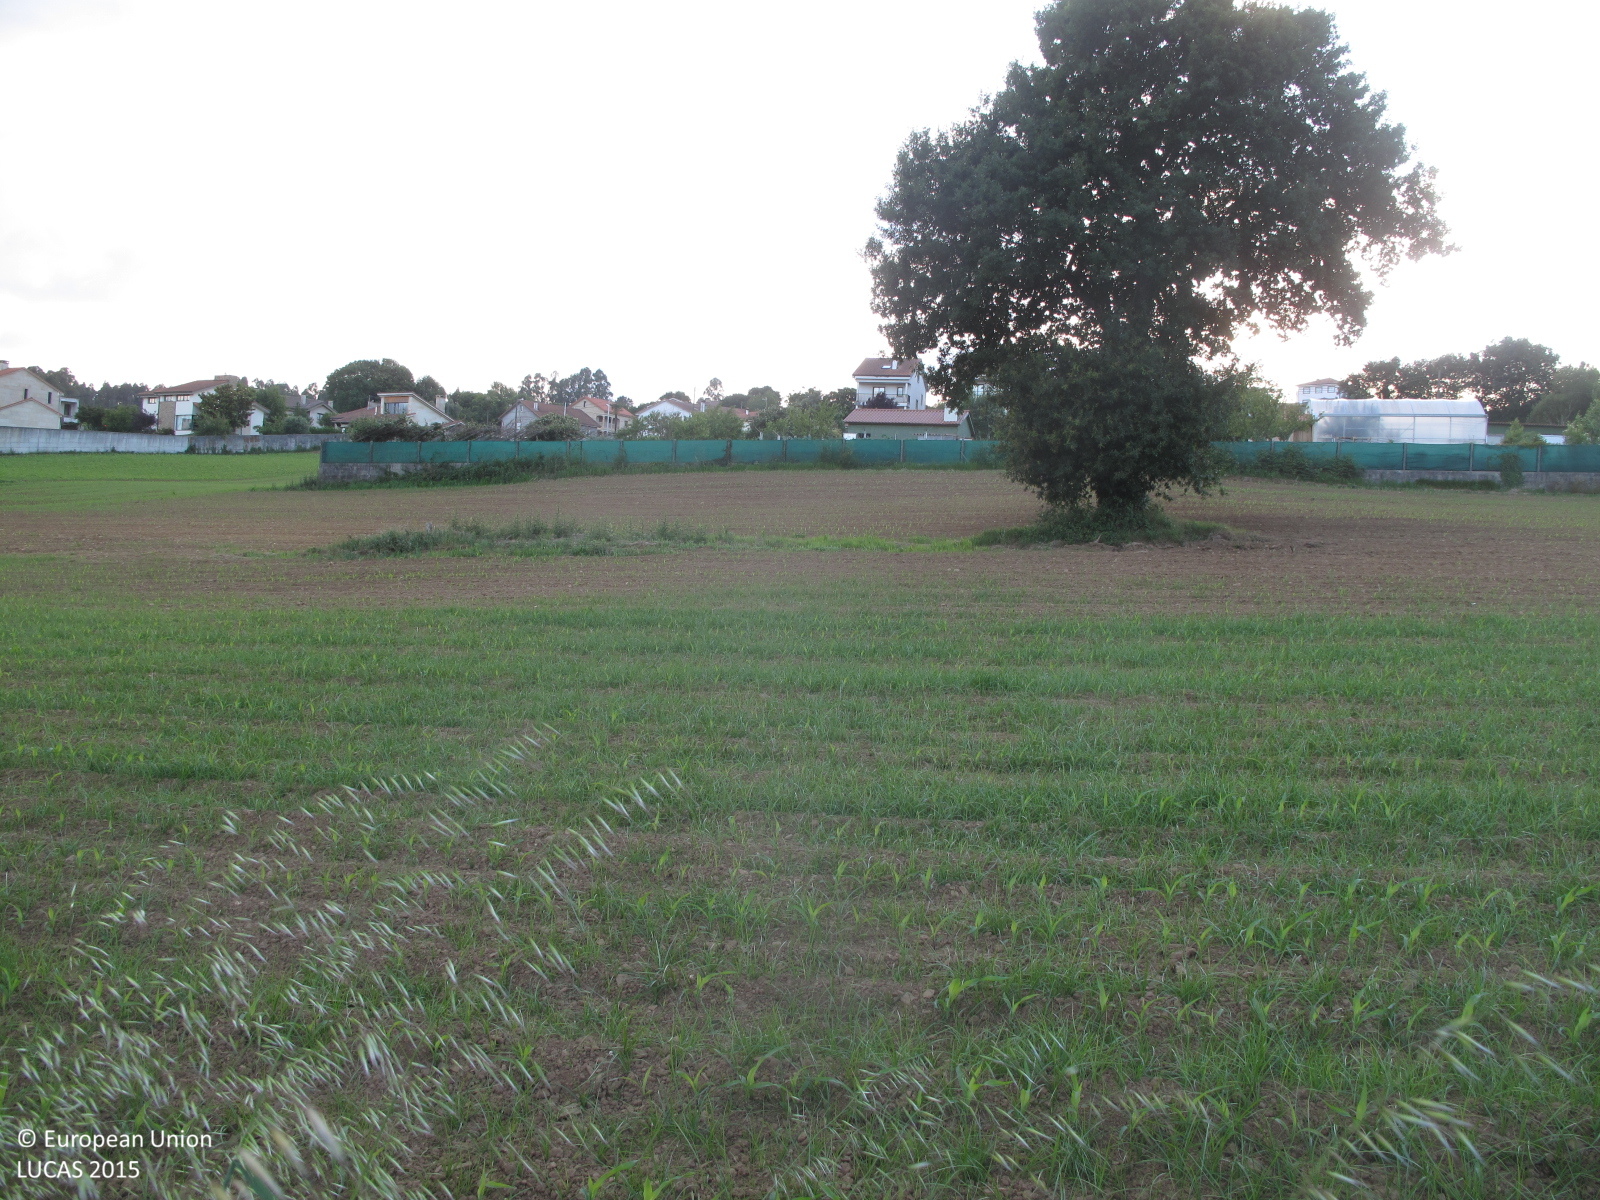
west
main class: Grassland
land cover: Grassland without tree/shrub cover
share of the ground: > 75 %
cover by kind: herbaceous plants 100 %
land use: Agriculture (excluding fallow land and kitchen gardens)
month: June
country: ES
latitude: 42.8719
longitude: -8.5021
